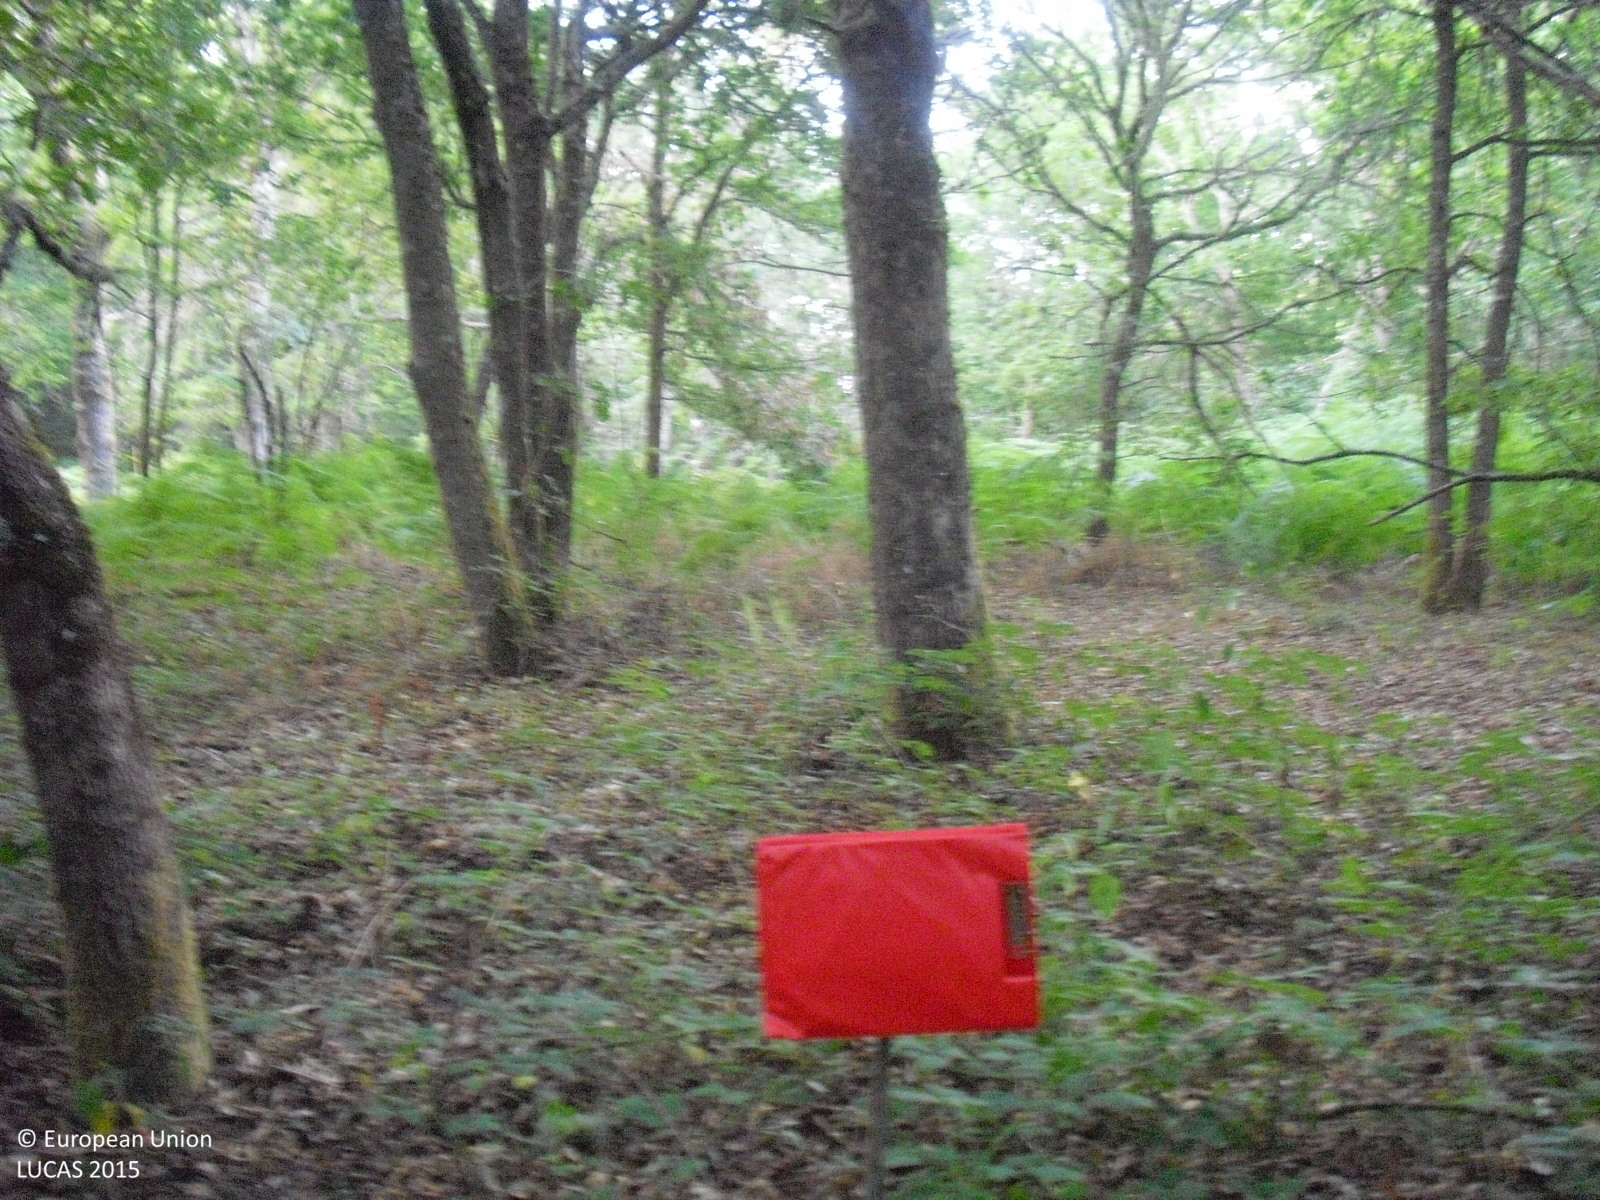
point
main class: Woodland
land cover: Broadleaved woodland
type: acidophilous oak and oak-birch forest
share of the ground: > 75 %
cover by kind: broadleaved forest trees 70 %, shrubs 30 %
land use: Forestry
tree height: > 5 m
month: July
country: ES
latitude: 42.3292
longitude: -7.7304
